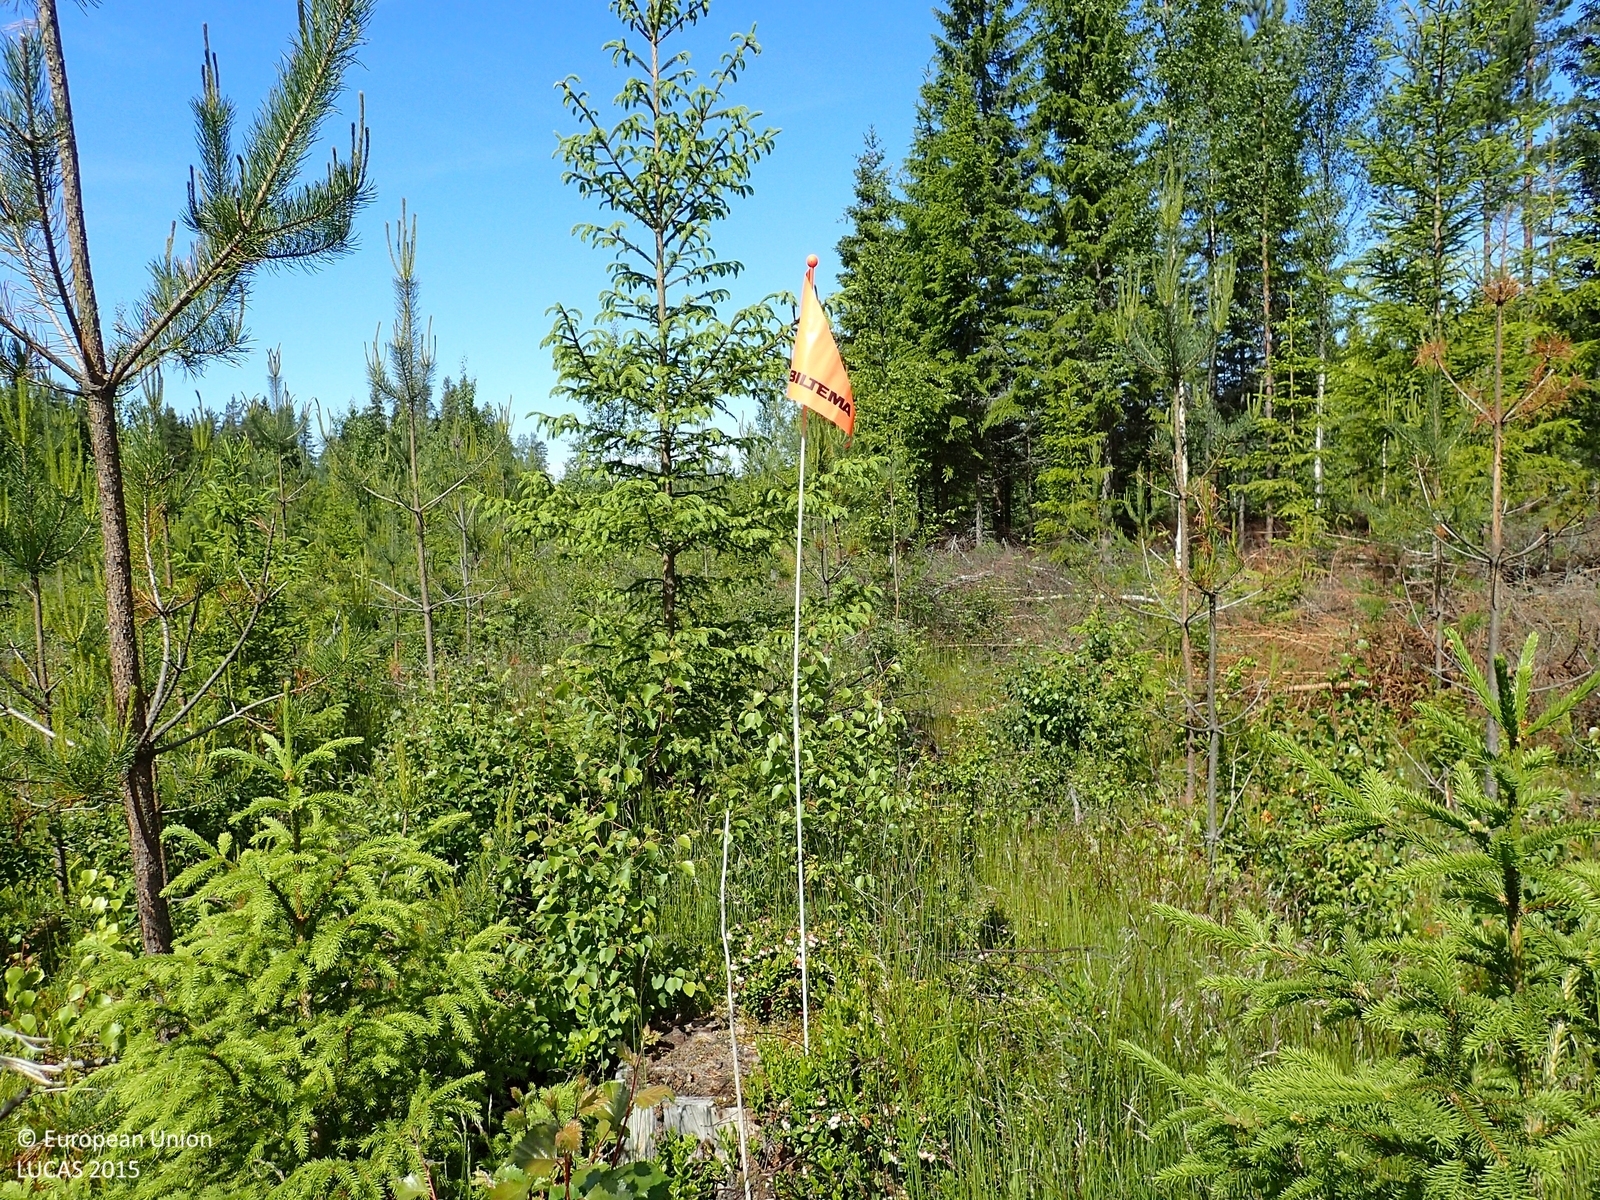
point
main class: Woodland
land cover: Pine dominated mixed woodland
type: boreal forest
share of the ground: 25 - 50 %
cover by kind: herbaceous plants 60 %, coniferous forest trees 15 %, broadleaved forest trees 15 %, shrubs 10 %
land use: Forestry
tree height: < 5 m
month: June
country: FI
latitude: 62.3794
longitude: 21.3924
